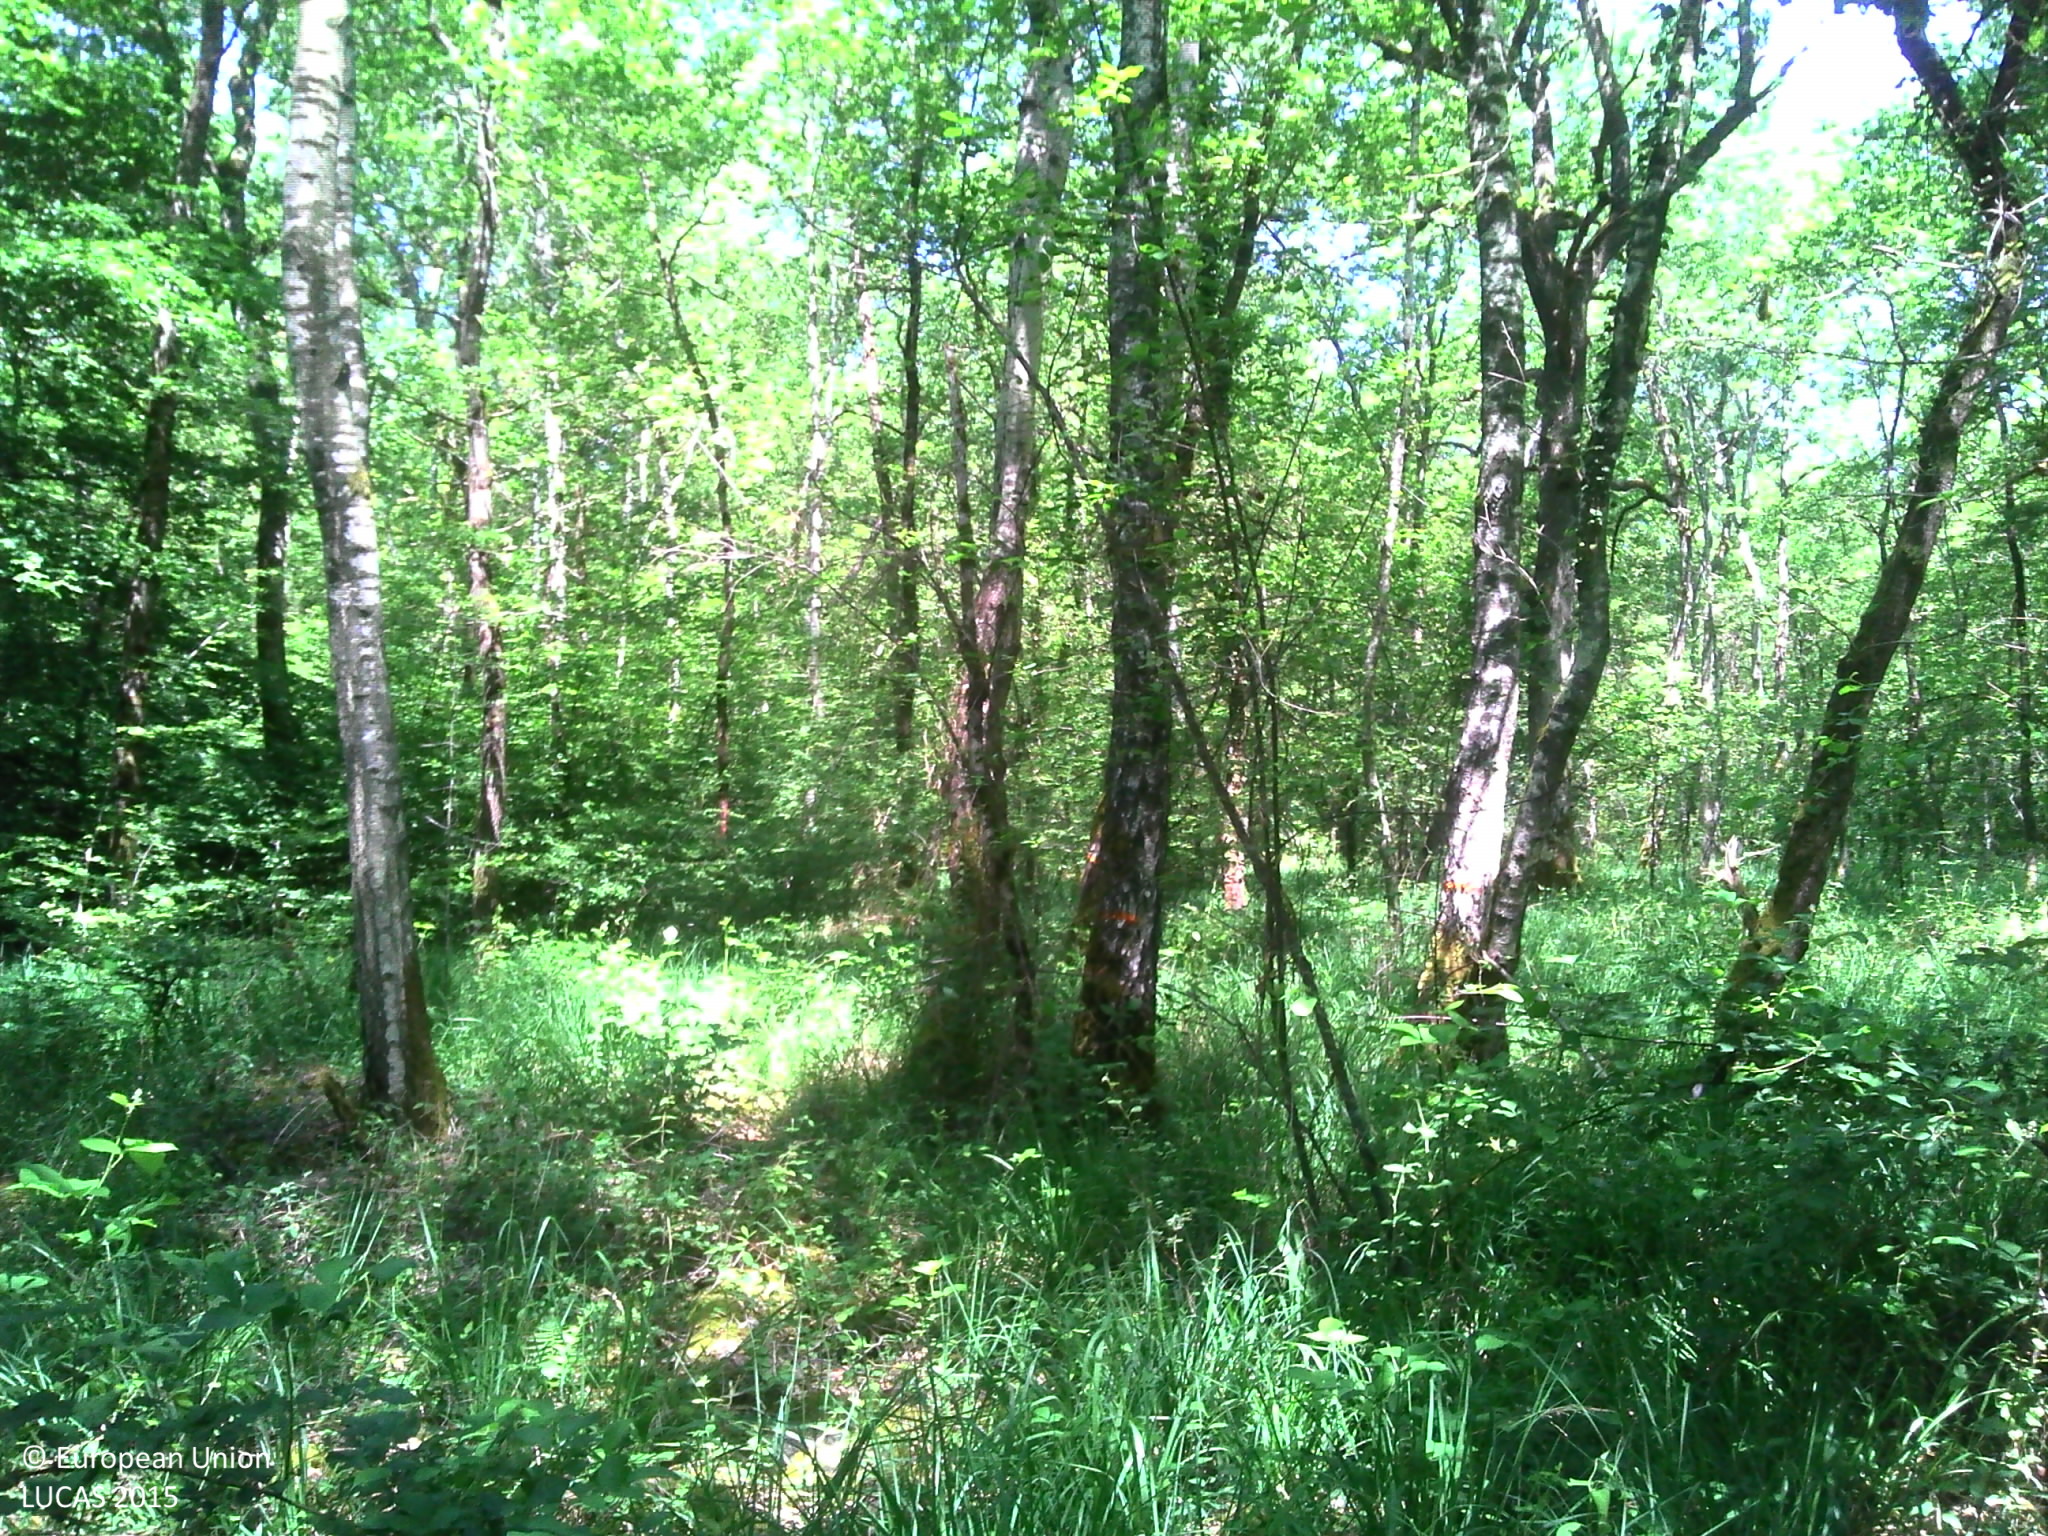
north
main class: Woodland
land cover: Broadleaved woodland
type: thermophilous deciduous forest
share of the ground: > 75 %
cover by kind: broadleaved forest trees 80 %, herbaceous plants 20 %
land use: Forestry
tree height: > 5 m
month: June
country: FR
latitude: 46.6201
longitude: 4.7648
